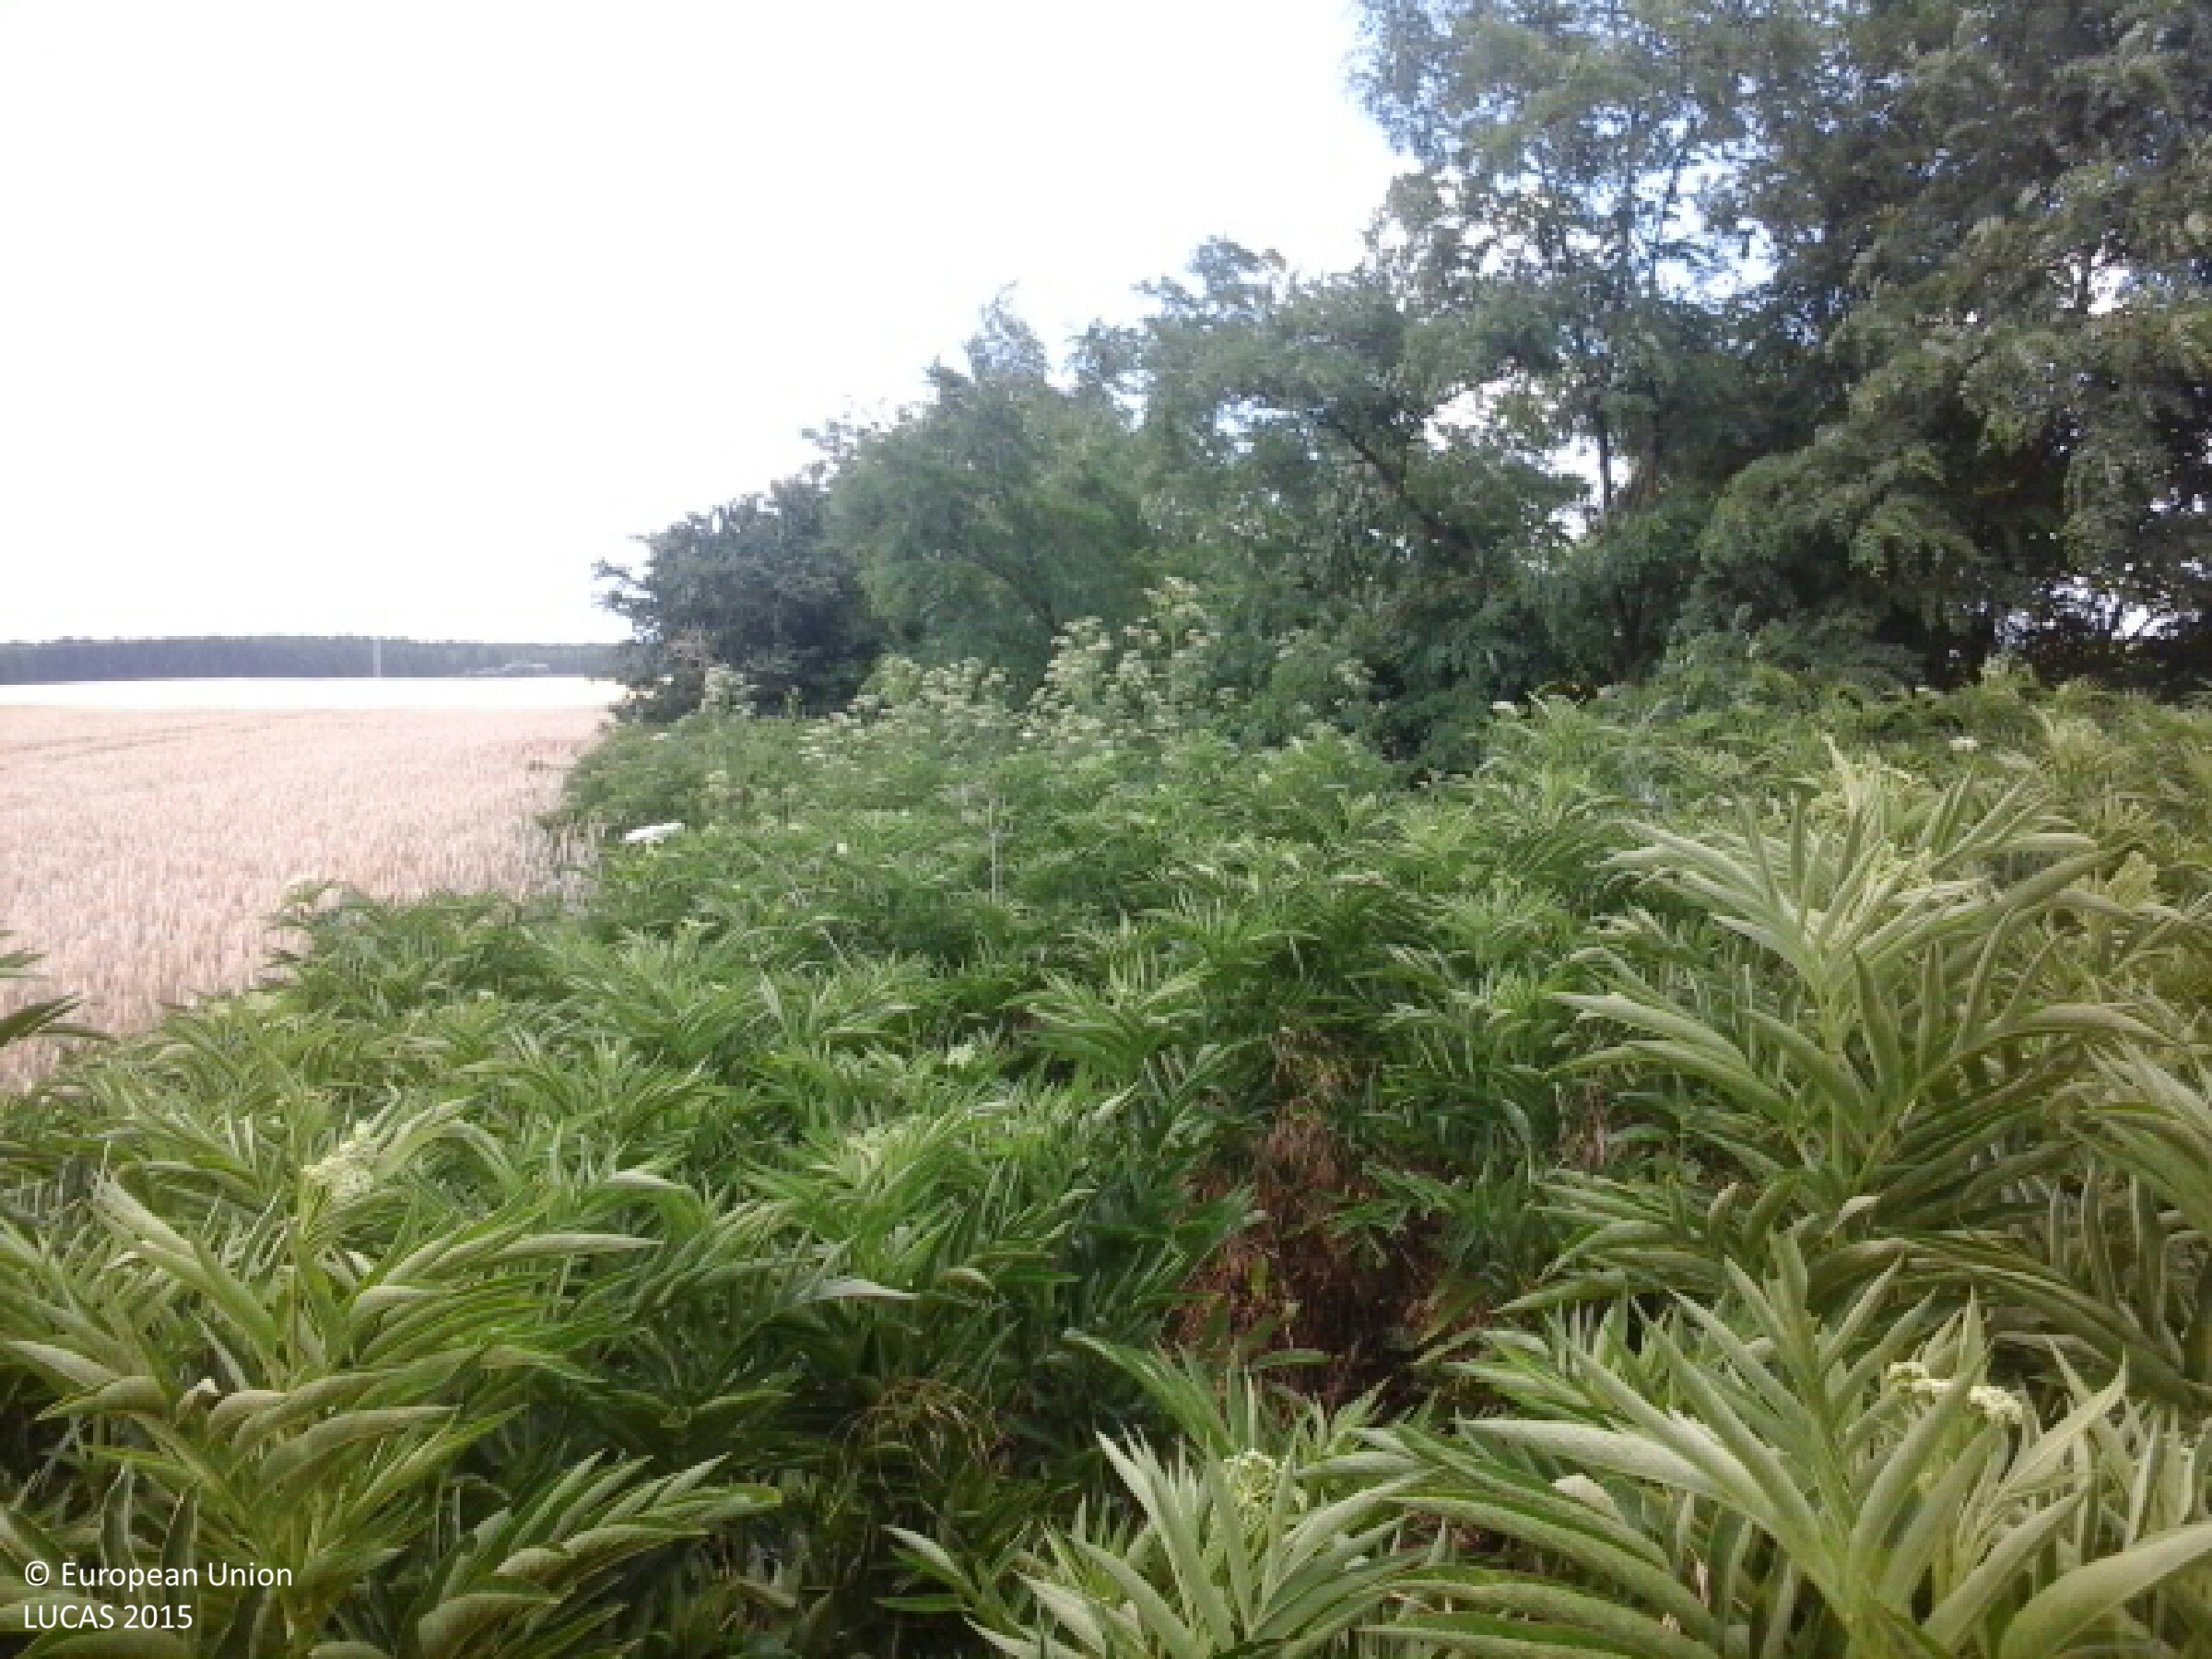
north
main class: Grassland
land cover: Spontaneously vegetated surfaces
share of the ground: > 75 %
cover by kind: herbaceous plants 95 %, shrubs 5 %
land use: Semi-natural and natural areas not in use
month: June
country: HU
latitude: 48.0697
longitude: 21.7108
